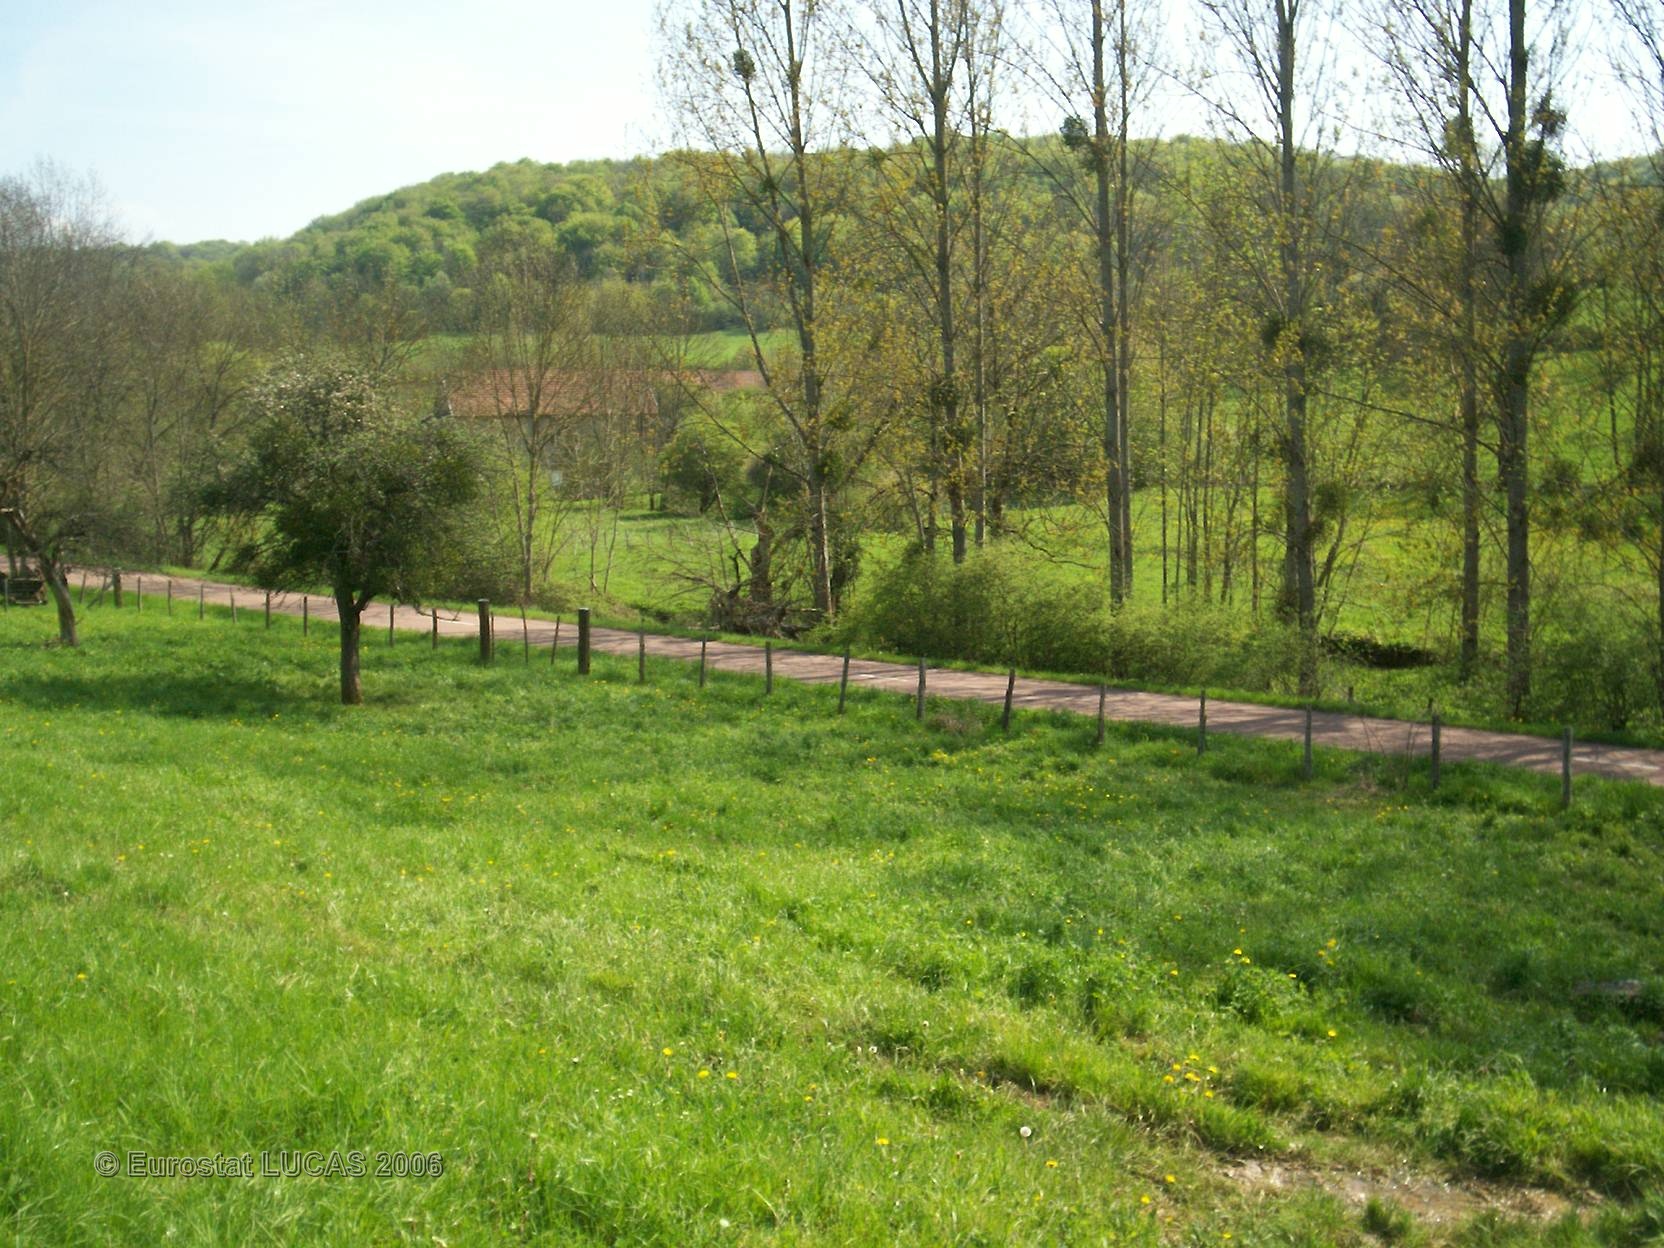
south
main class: Grassland
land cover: Grassland without tree/shrub cover
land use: Agriculture (excluding fallow land and kitchen gardens)
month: May
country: FR
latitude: 47.5331
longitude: 4.6195
